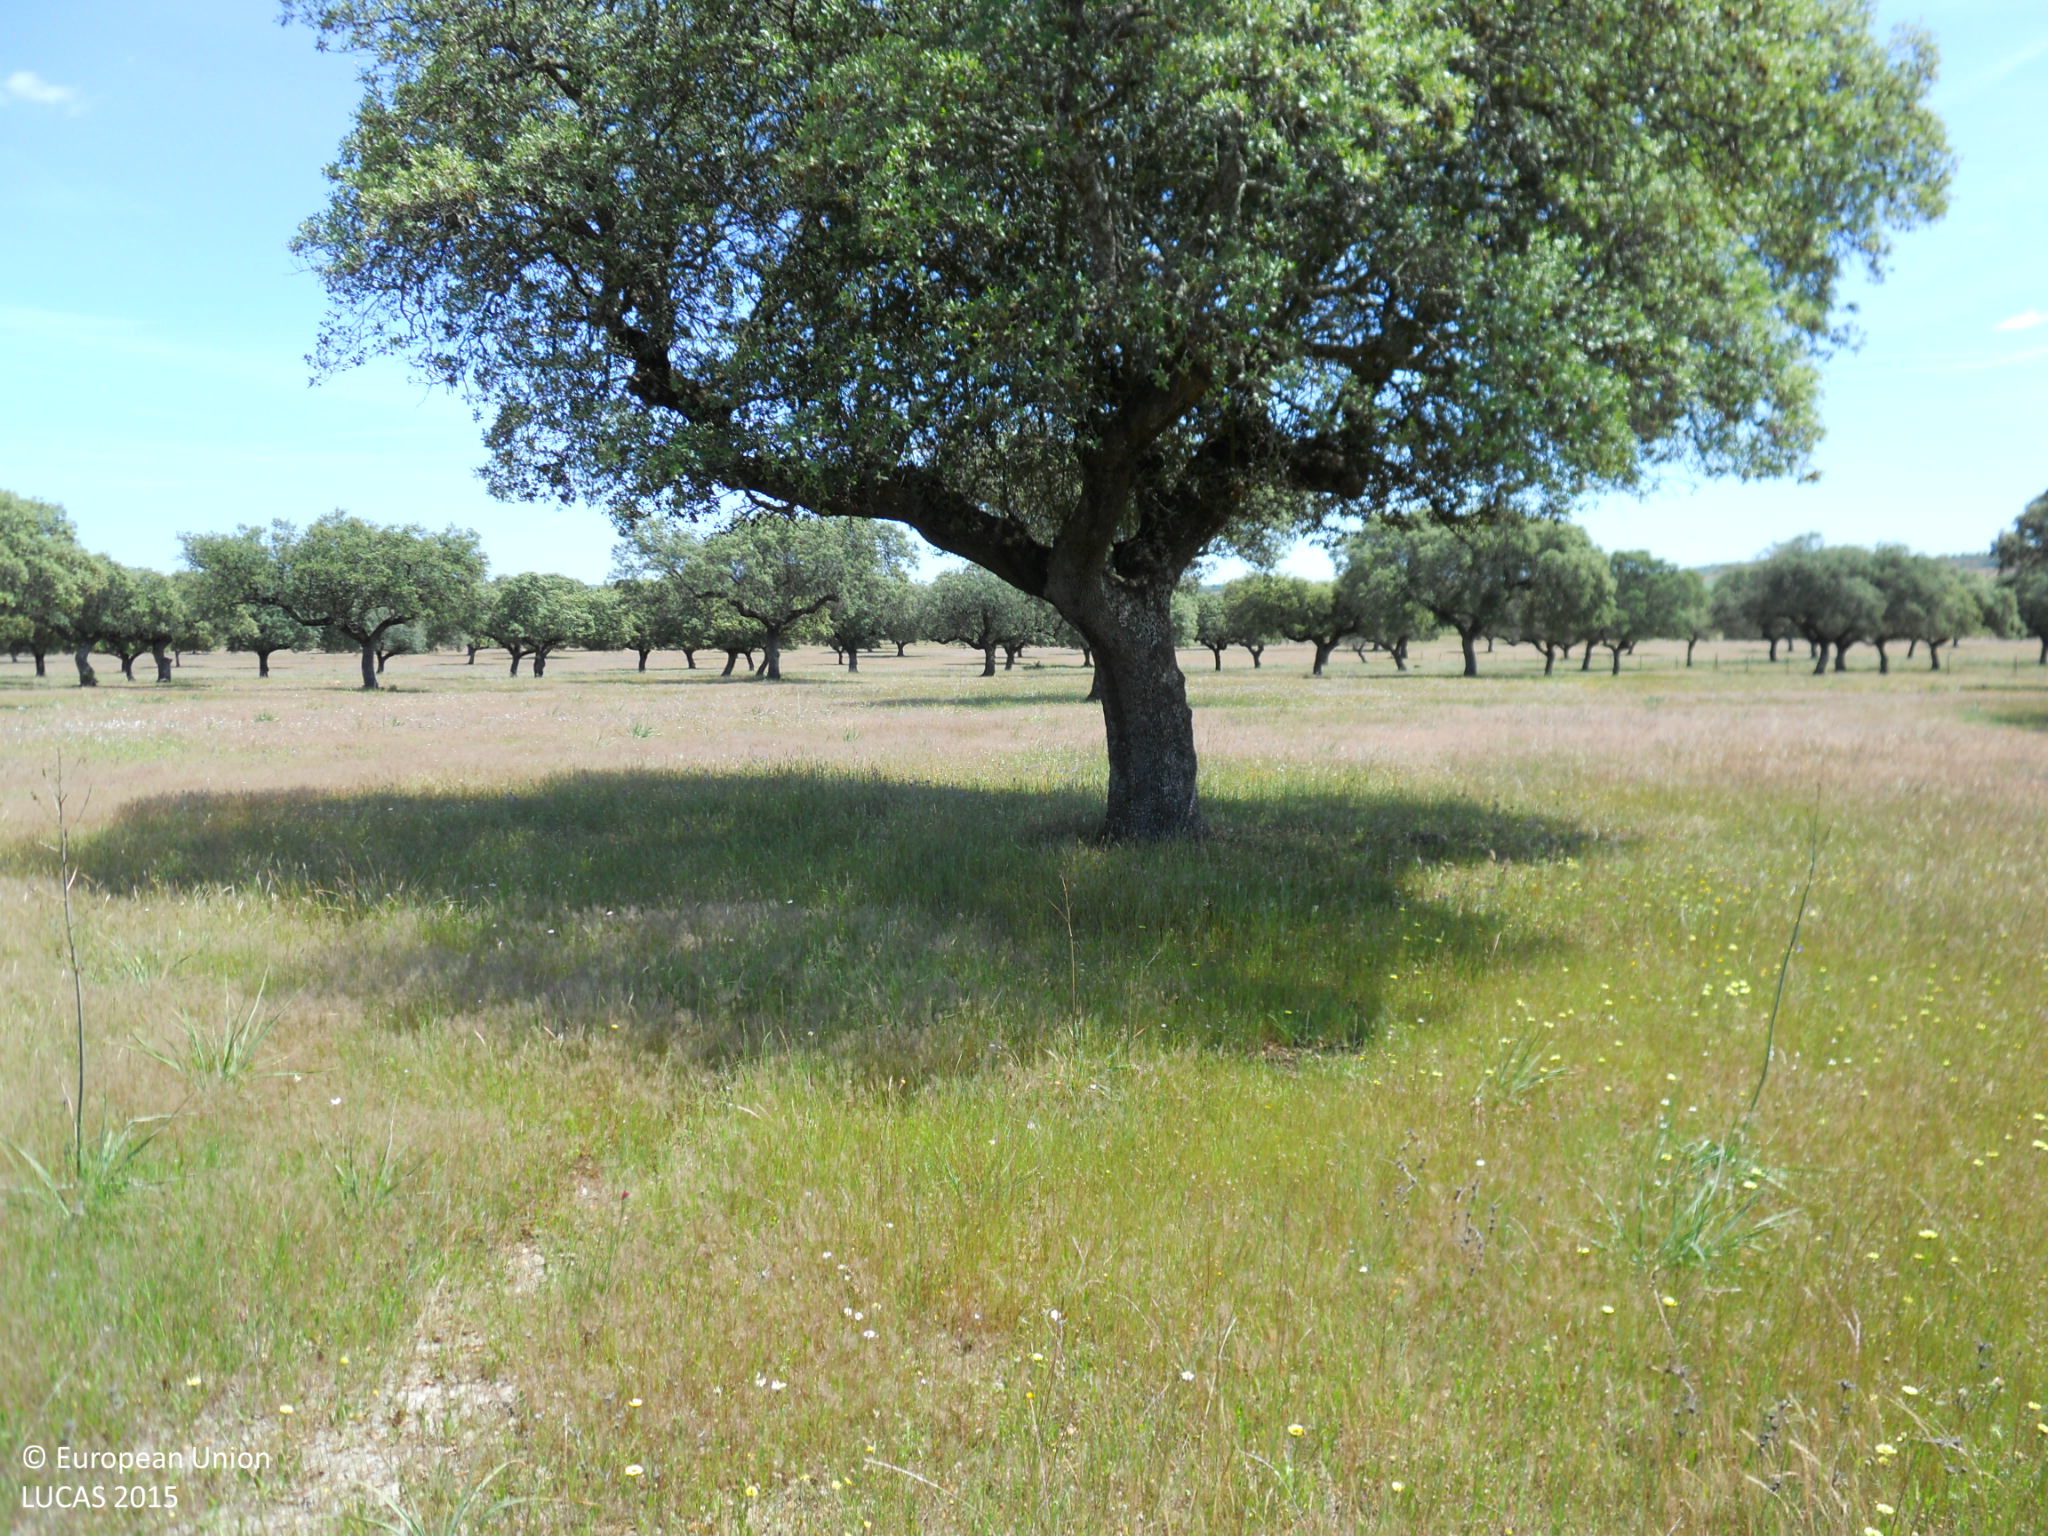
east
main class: Woodland
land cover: Broadleaved woodland
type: broadleaved evergreen forest
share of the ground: > 75 %
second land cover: Grassland without tree/shrub cover
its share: 50 - 75 %
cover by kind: broadleaved forest trees 90 %, herbaceous plants 10 %
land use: Forestry
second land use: Agriculture (excluding fallow land and kitchen gardens)
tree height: > 5 m
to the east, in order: Broadleaved woodland; Grassland without tree/shrub cover
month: April
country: ES
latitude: 39.0958
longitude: -6.7299
